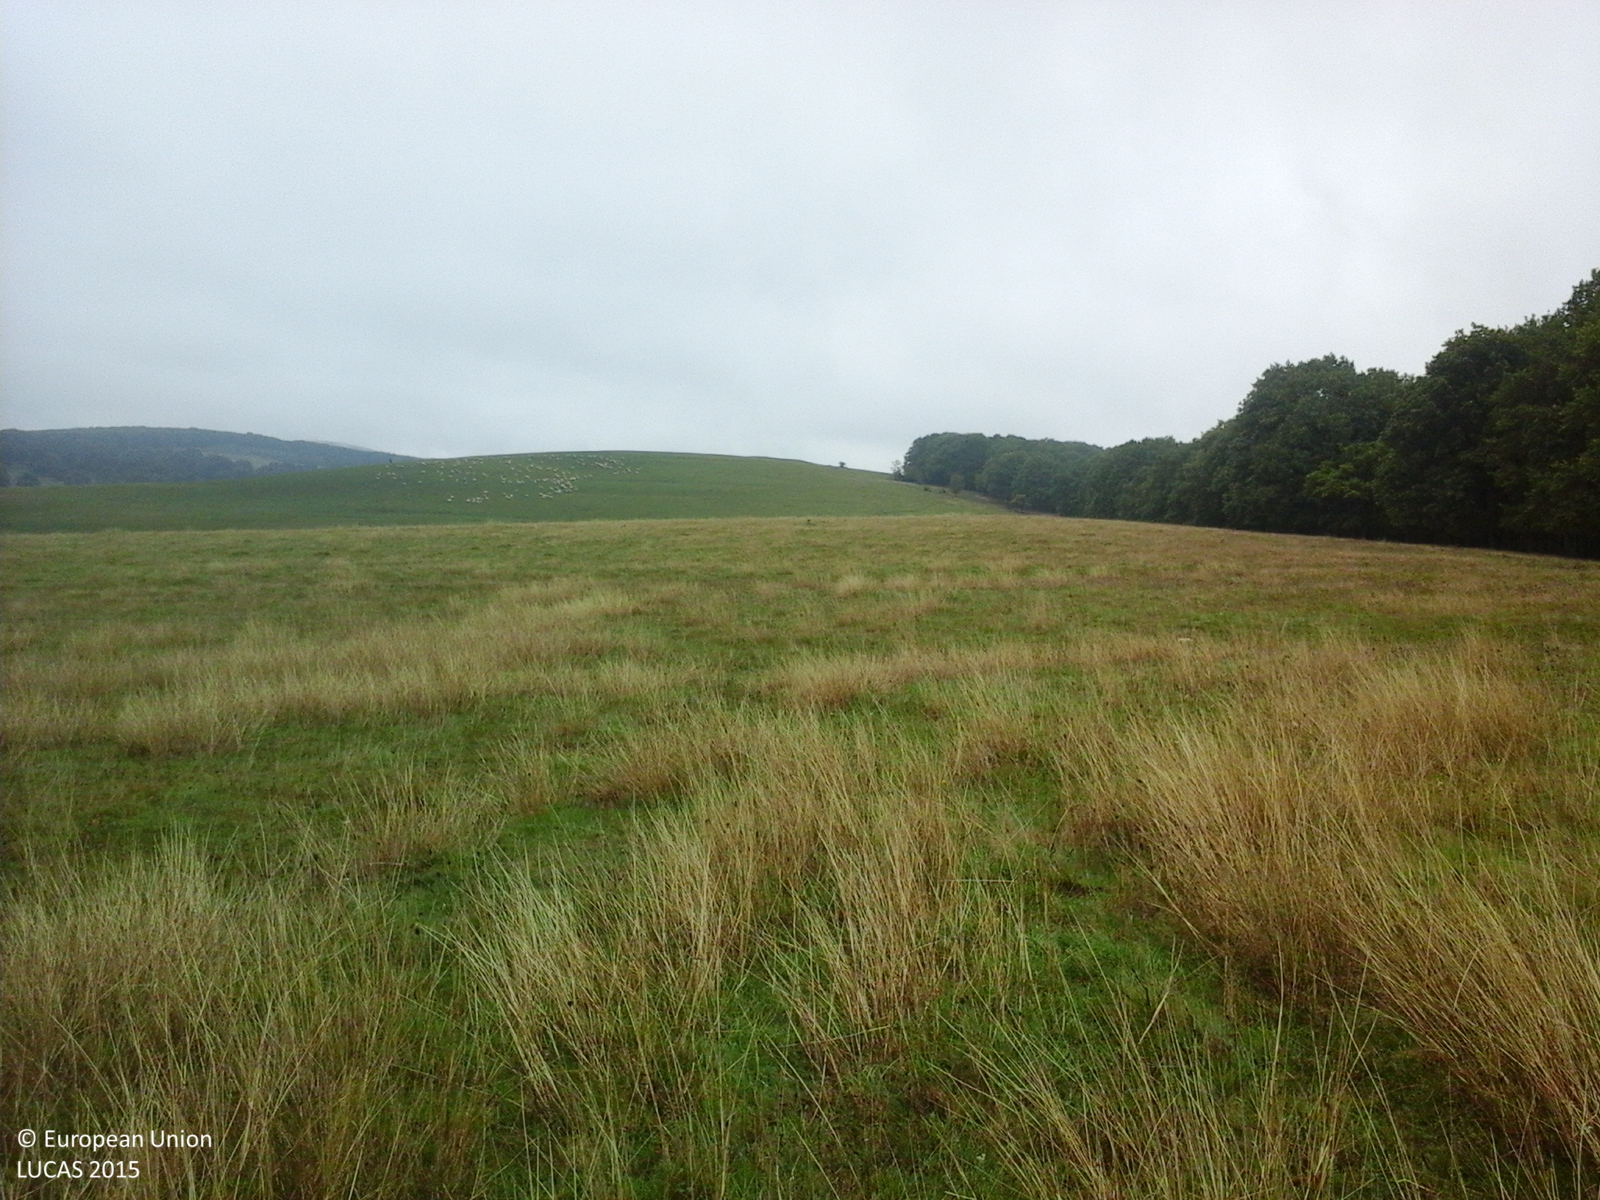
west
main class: Grassland
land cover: Grassland without tree/shrub cover
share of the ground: > 75 %
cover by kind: herbaceous plants 100 %
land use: Agriculture (excluding fallow land and kitchen gardens)
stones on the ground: < 10 %
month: October
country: RO
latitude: 45.8075
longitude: 24.0082
